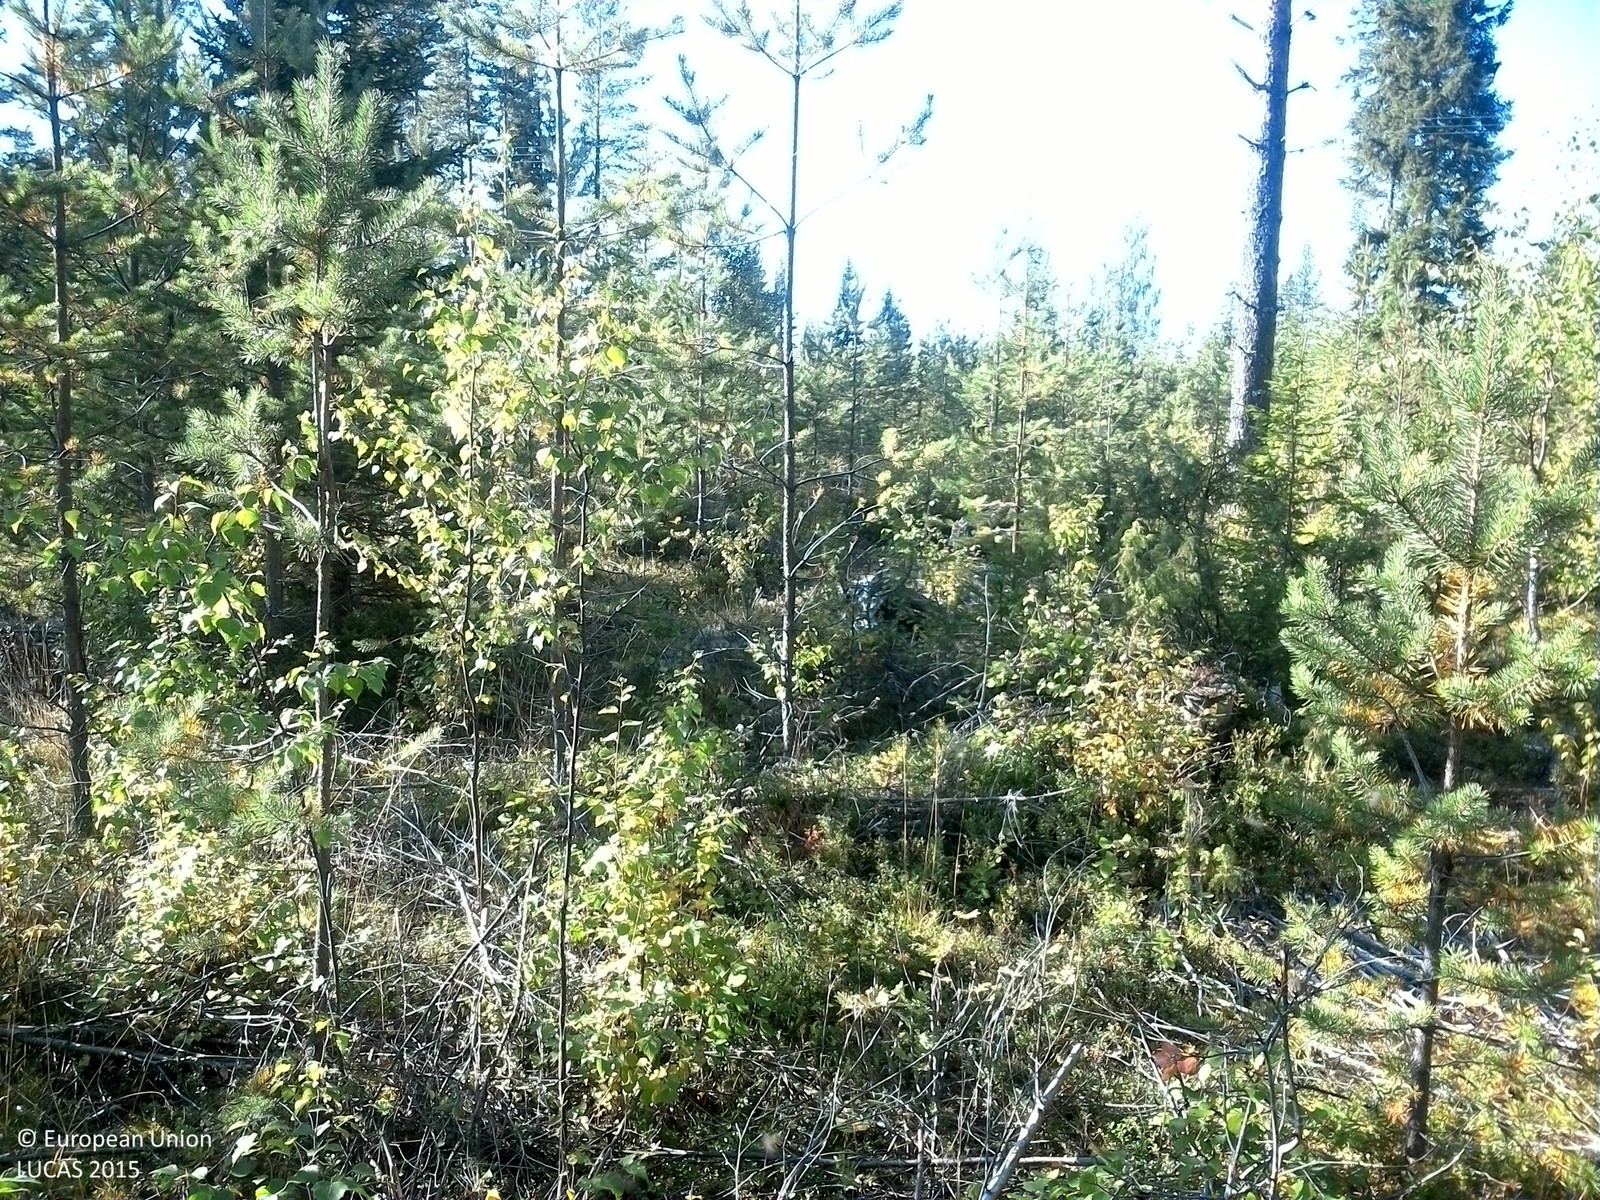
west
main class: Woodland
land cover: Pine dominated mixed woodland
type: boreal forest
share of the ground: 50 - 75 %
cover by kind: coniferous forest trees 35 %, shrubs 30 %, broadleaved forest trees 15 %, herbaceous plants 10 %, lichens and mosses 10 %
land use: Forestry
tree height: > 5 m
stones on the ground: 10 - 25 %
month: September
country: SE
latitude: 61.7718
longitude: 14.9678
